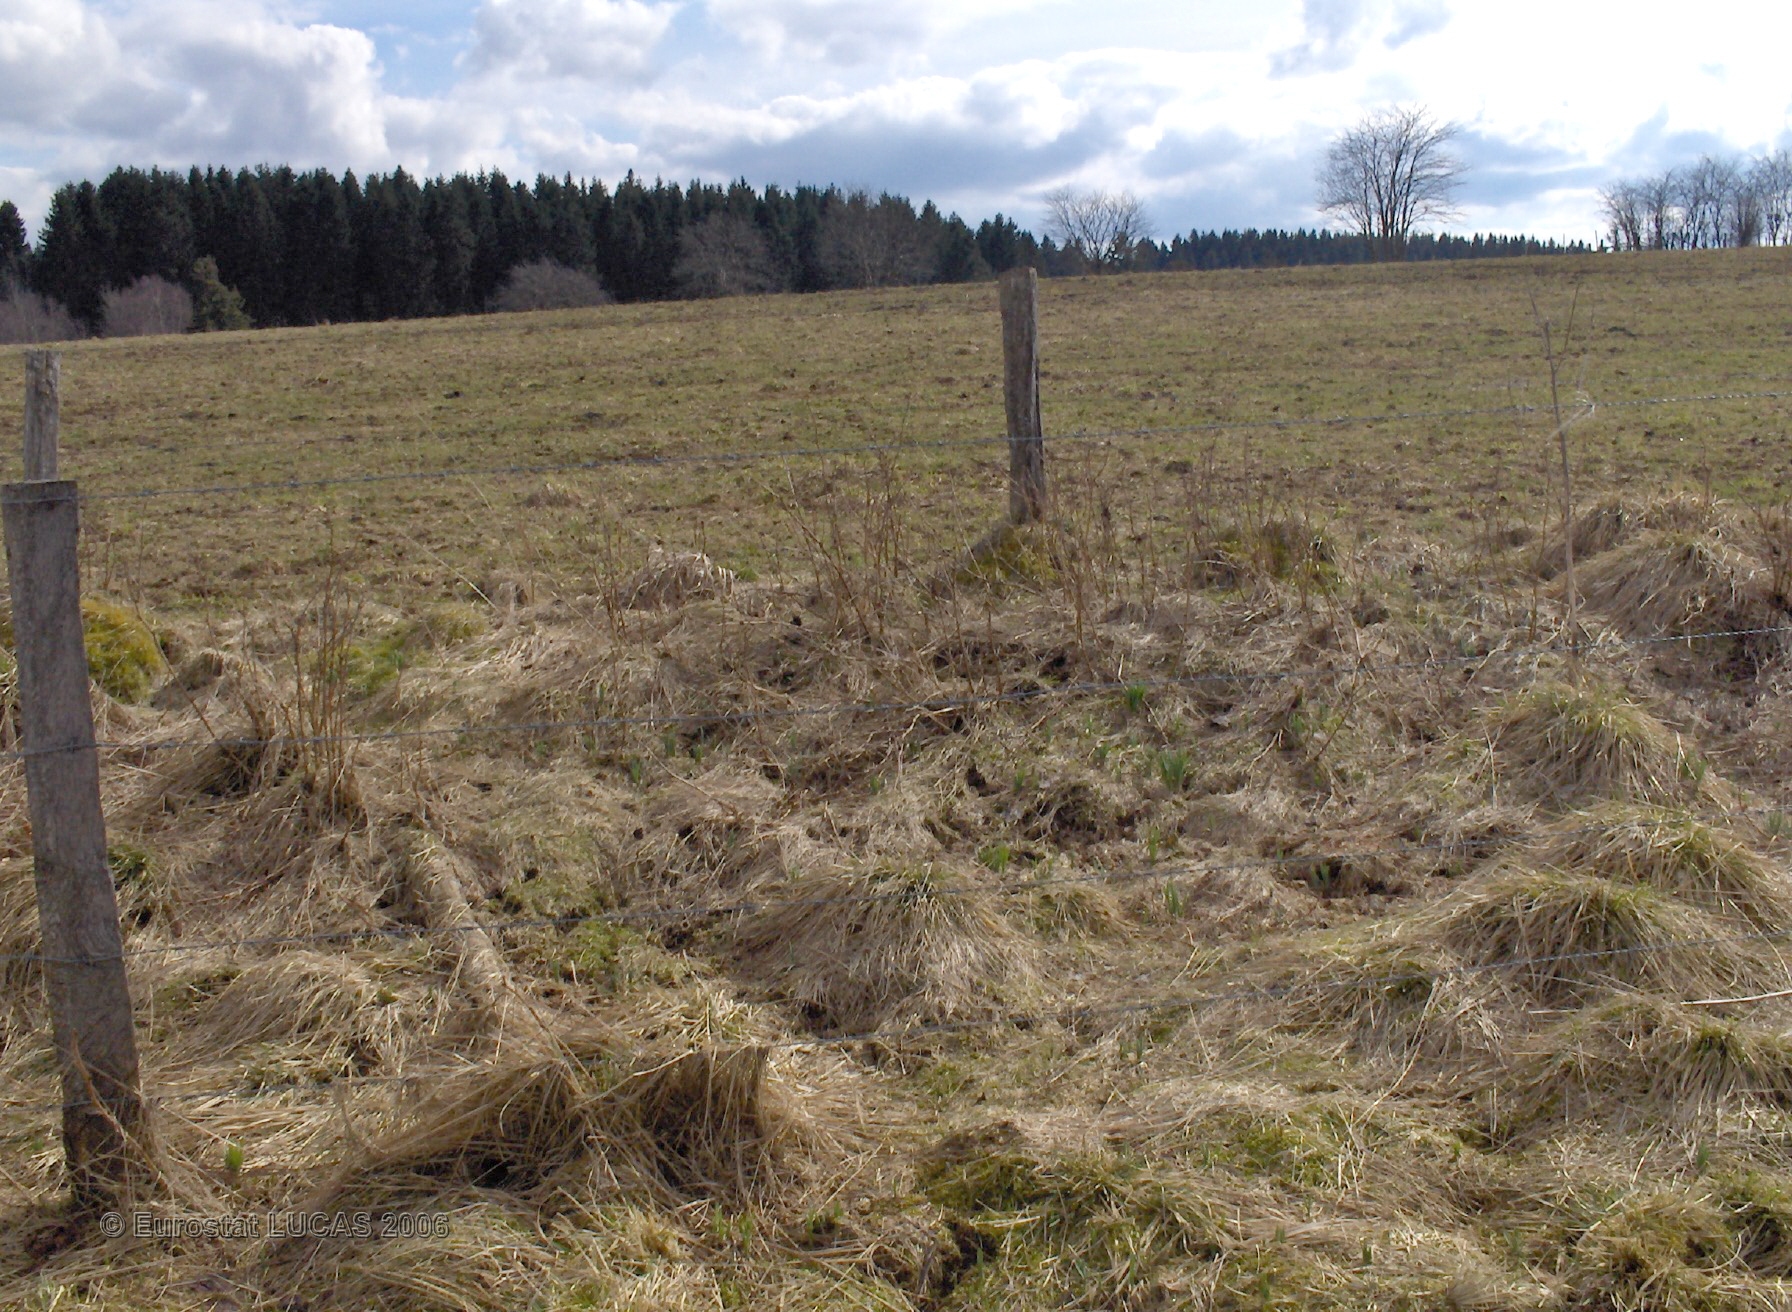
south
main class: Grassland
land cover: Grassland with sparse tree/shrub cover
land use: Unused
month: April
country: BE
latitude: 50.3951
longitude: 6.3279
